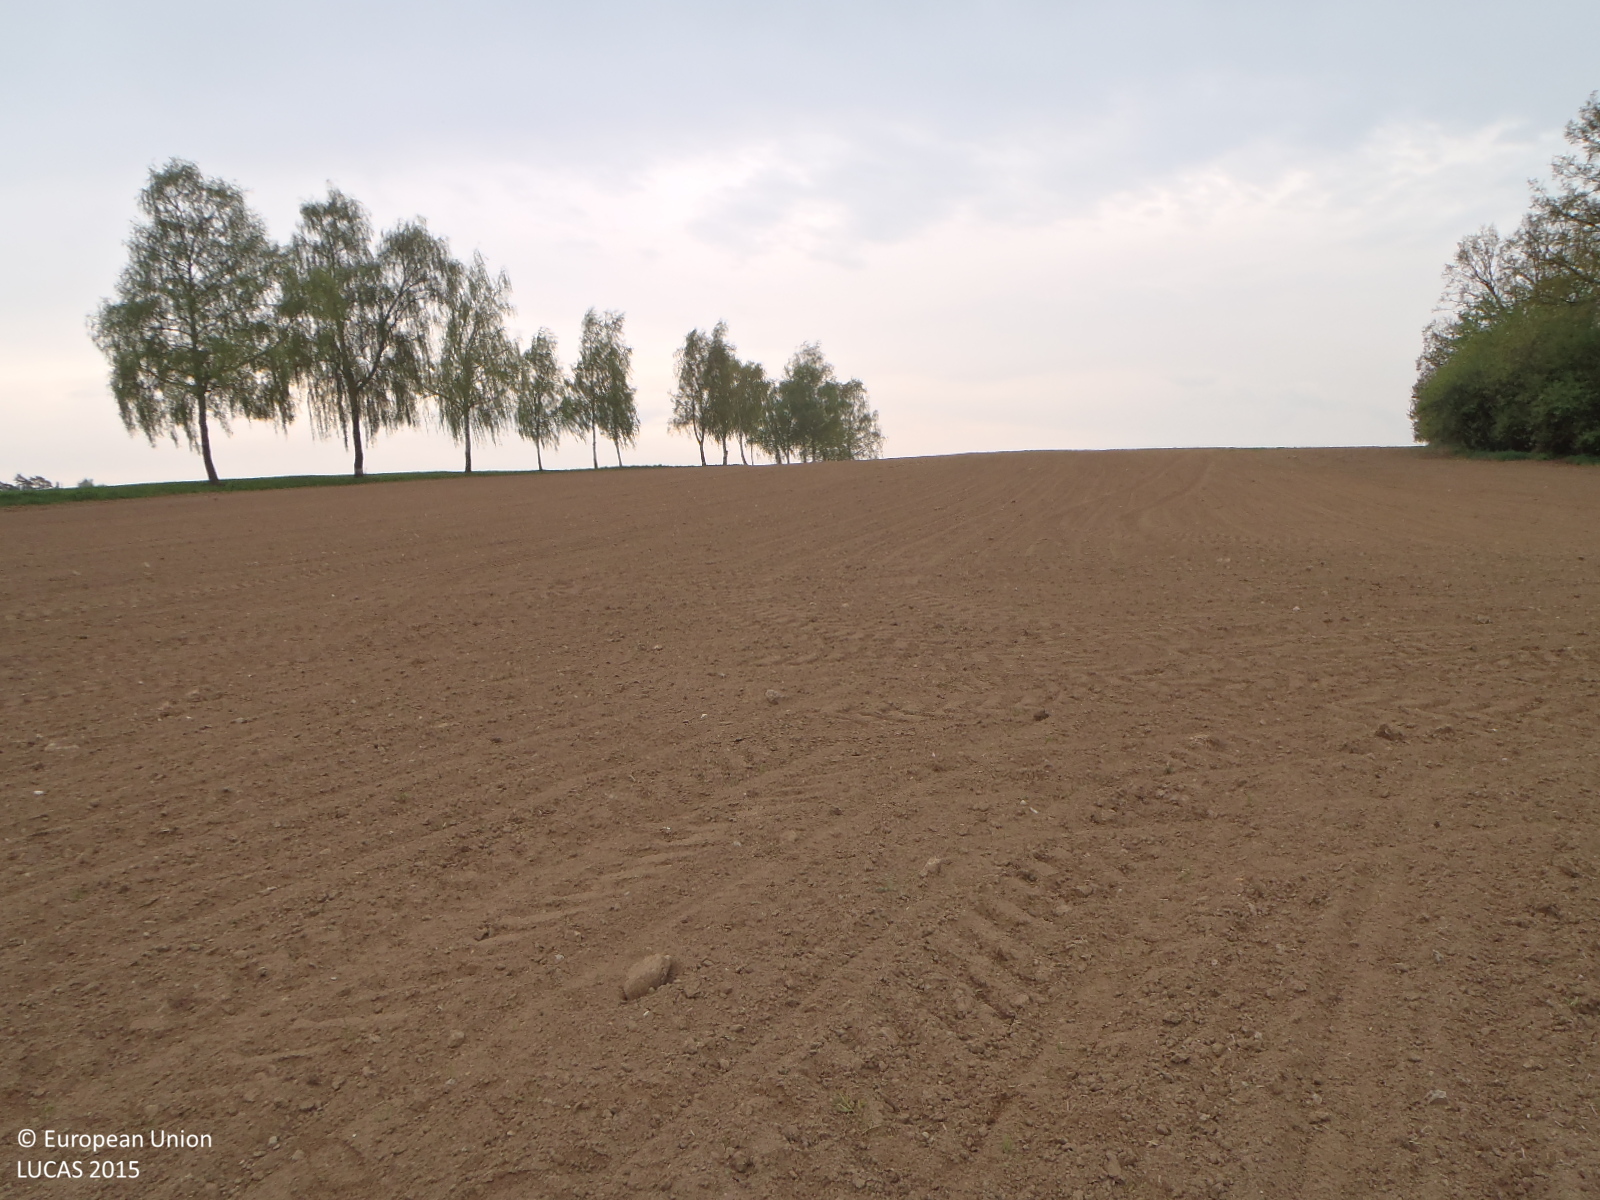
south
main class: Cropland
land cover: Maize
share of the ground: < 10 %
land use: Agriculture (excluding fallow land and kitchen gardens)
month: May
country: CZ
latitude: 49.2221
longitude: 15.1239
